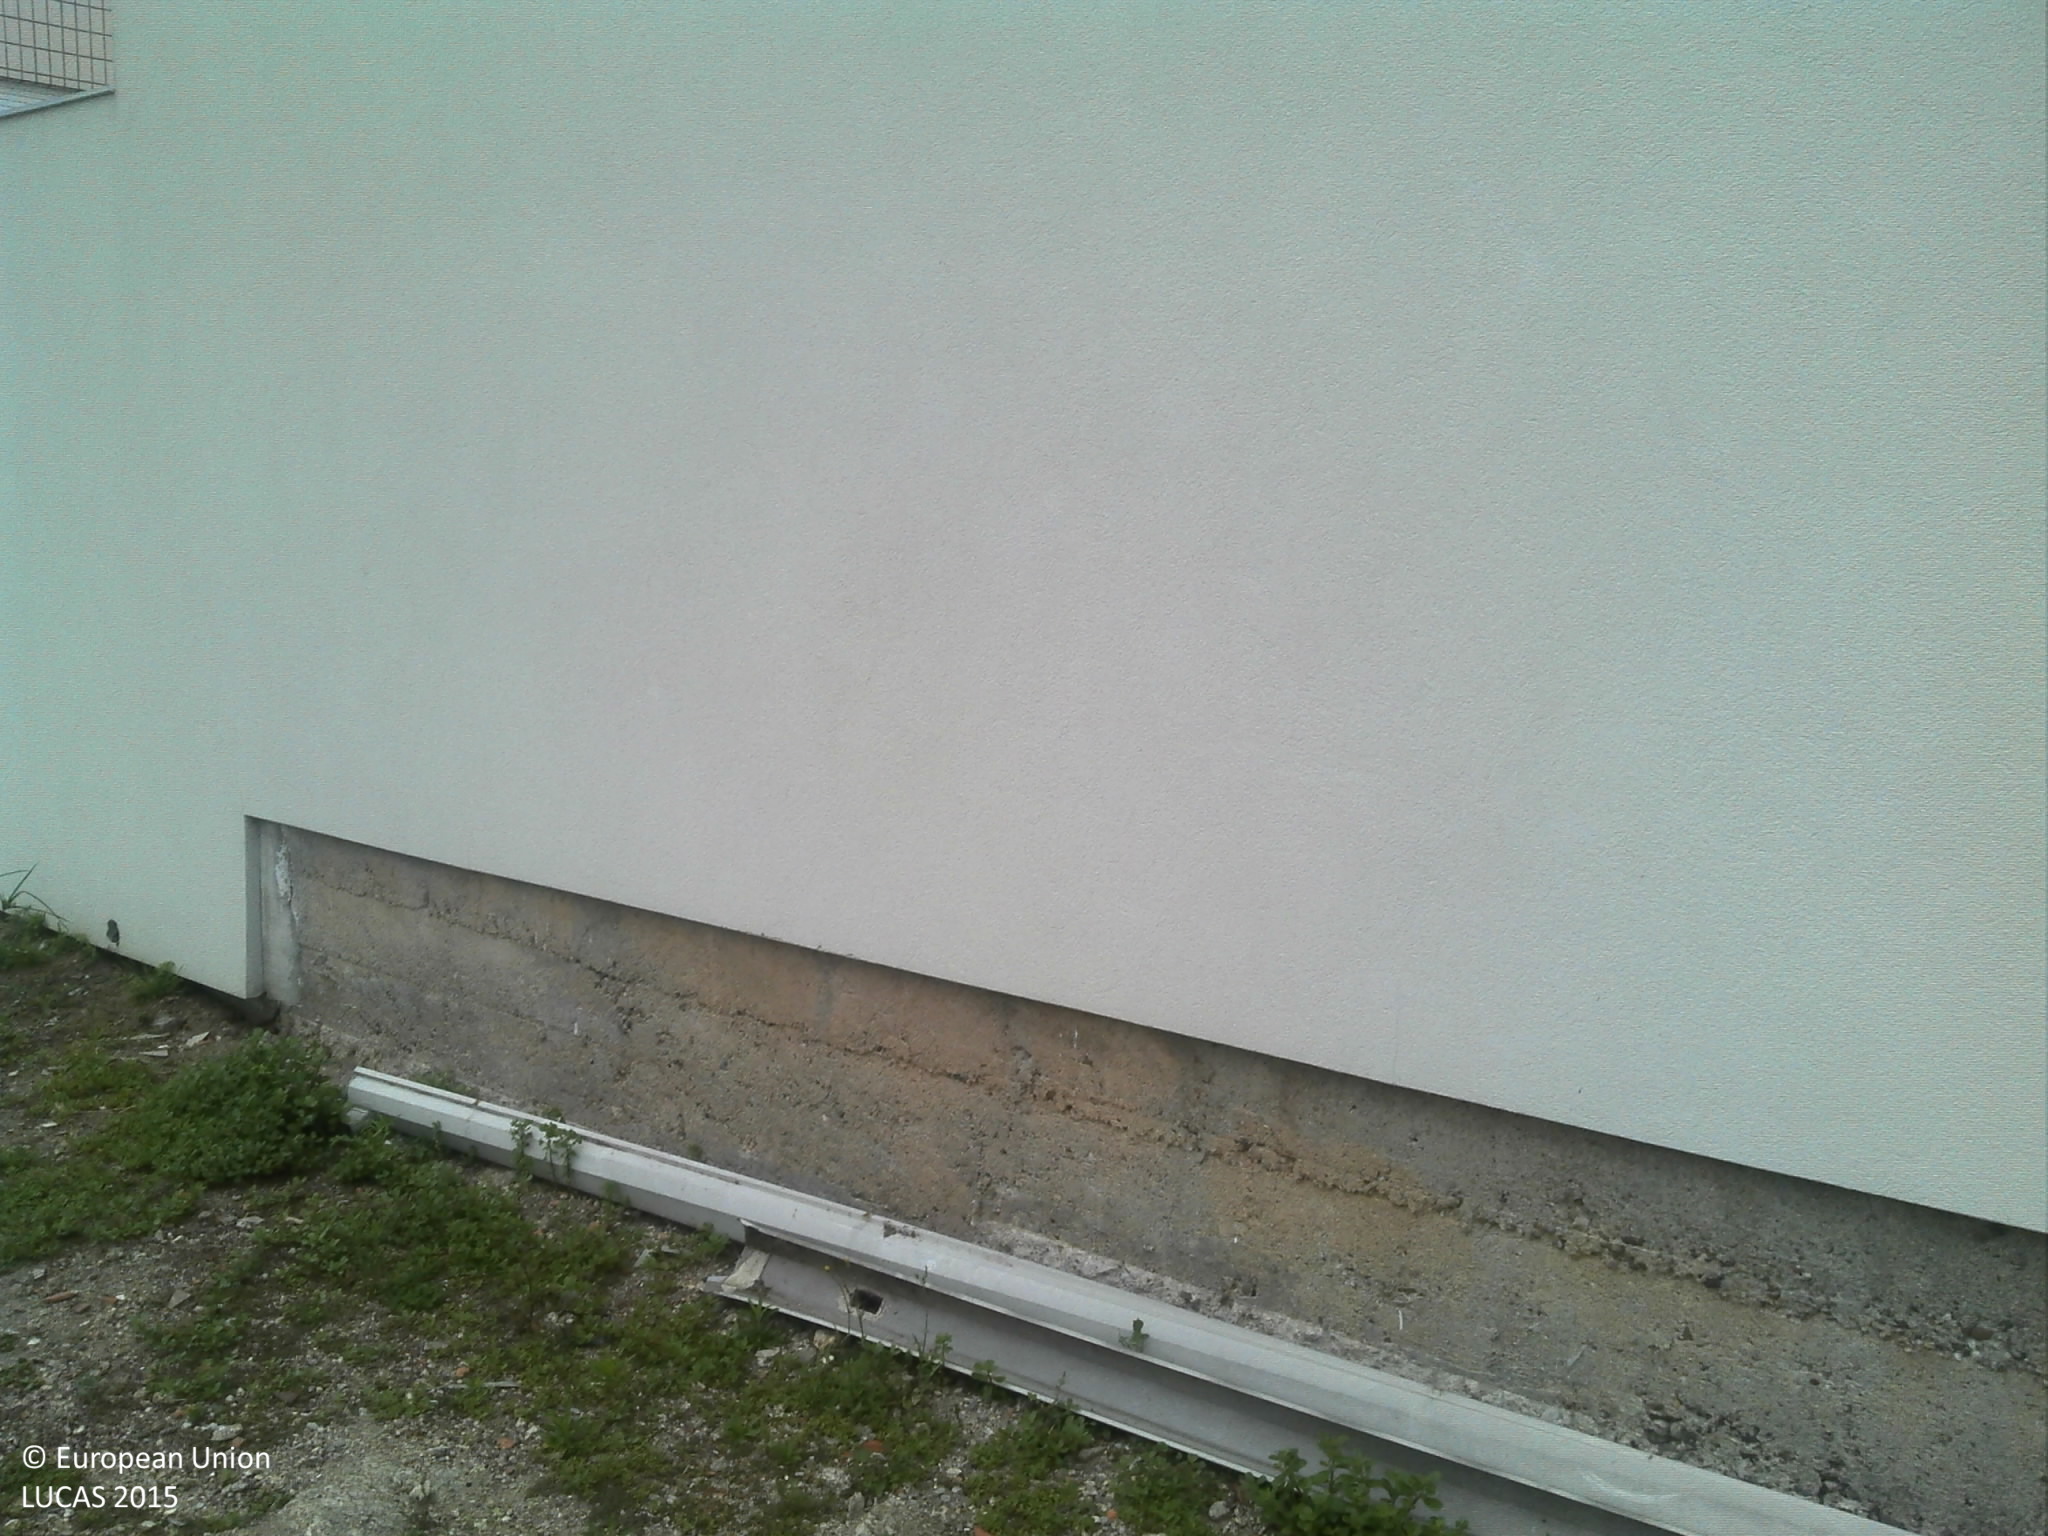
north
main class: Shrubland
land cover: Shrubland without tree cover
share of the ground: 50 - 75 %
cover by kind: herbaceous plants 60 %, unconsolidated bare surface 25 %, shrubs 15 %
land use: Residential
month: June
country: PT
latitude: 41.1820
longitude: -8.1530
